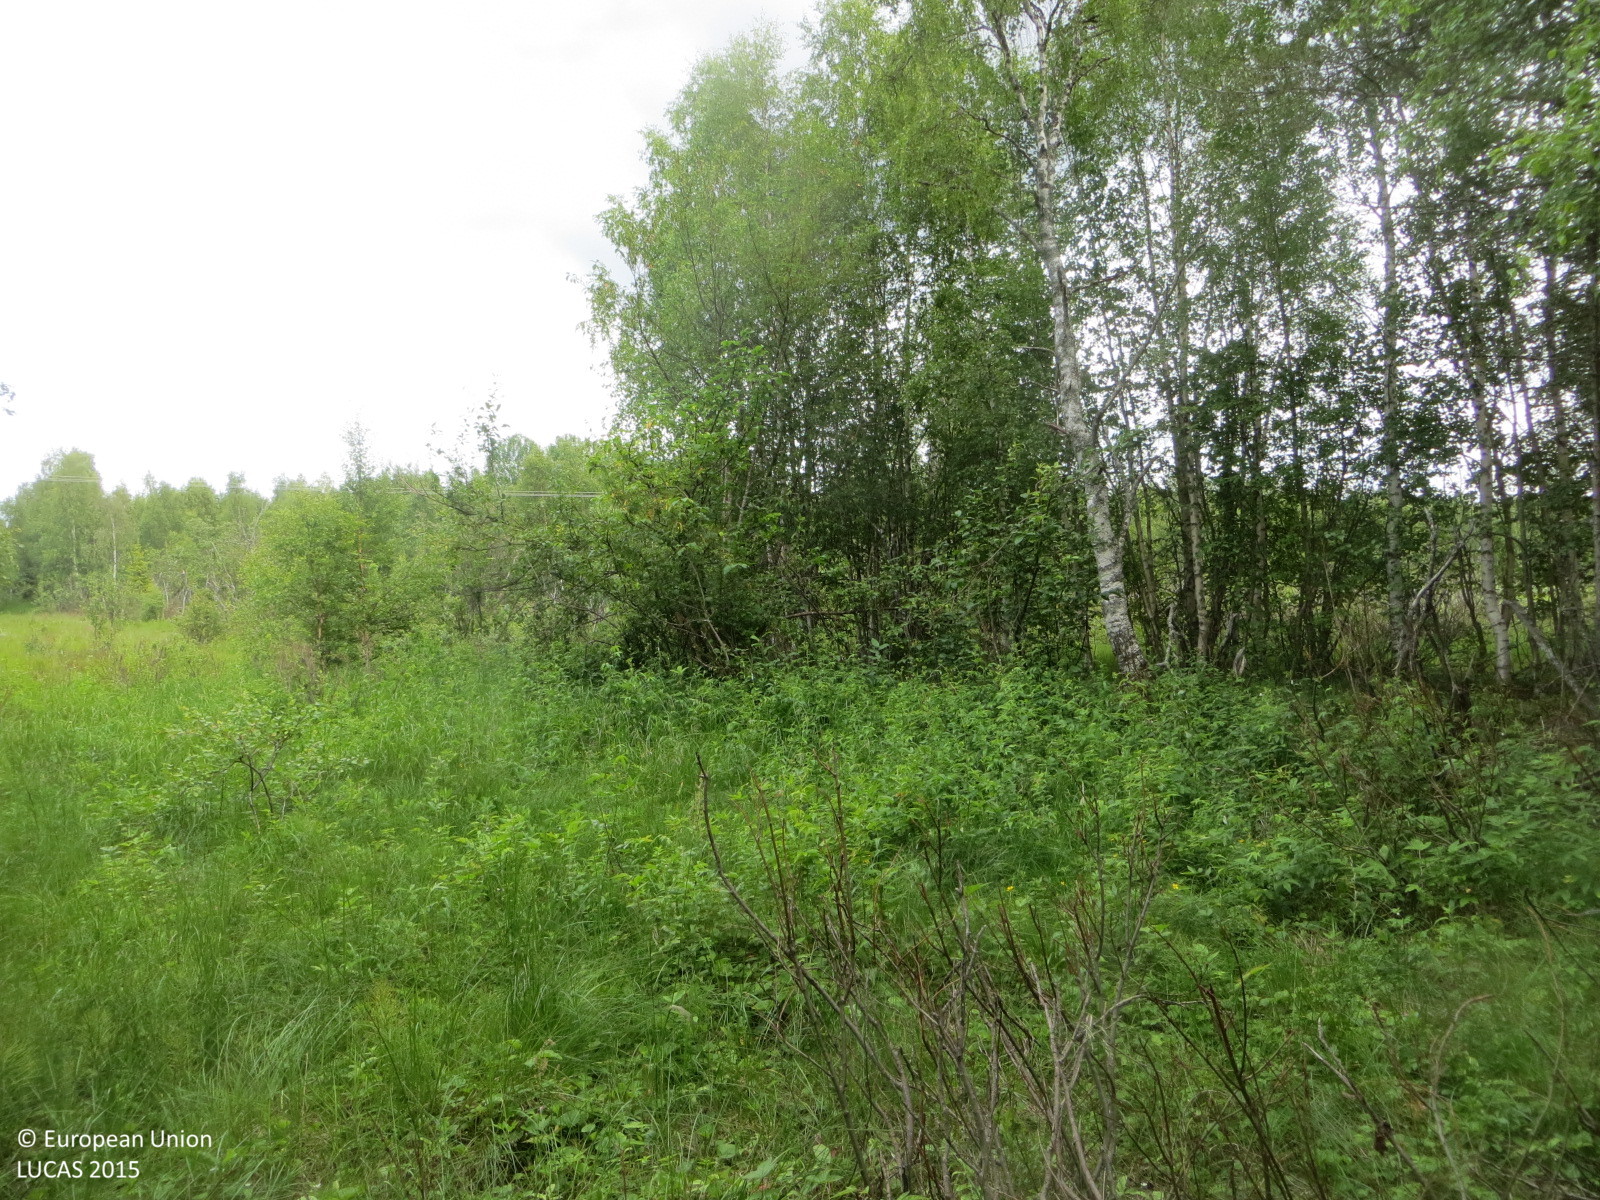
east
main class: Woodland
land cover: Broadleaved woodland
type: boreal forest
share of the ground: 25 - 50 %
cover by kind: herbaceous plants 55 %, broadleaved forest trees 45 %
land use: Forestry
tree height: > 5 m
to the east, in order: Broadleaved woodland; Ditches and canals; Broadleaved woodland; Grassland with sparse tree/shrub cover; Electric lines; Grassland with sparse tree/shrub cover; Broadleaved woodland; Ditches and canals; Broadleaved woodland; Ditches and canals; Broadleaved woodland
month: July
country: FI
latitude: 66.2475
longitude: 23.7184
